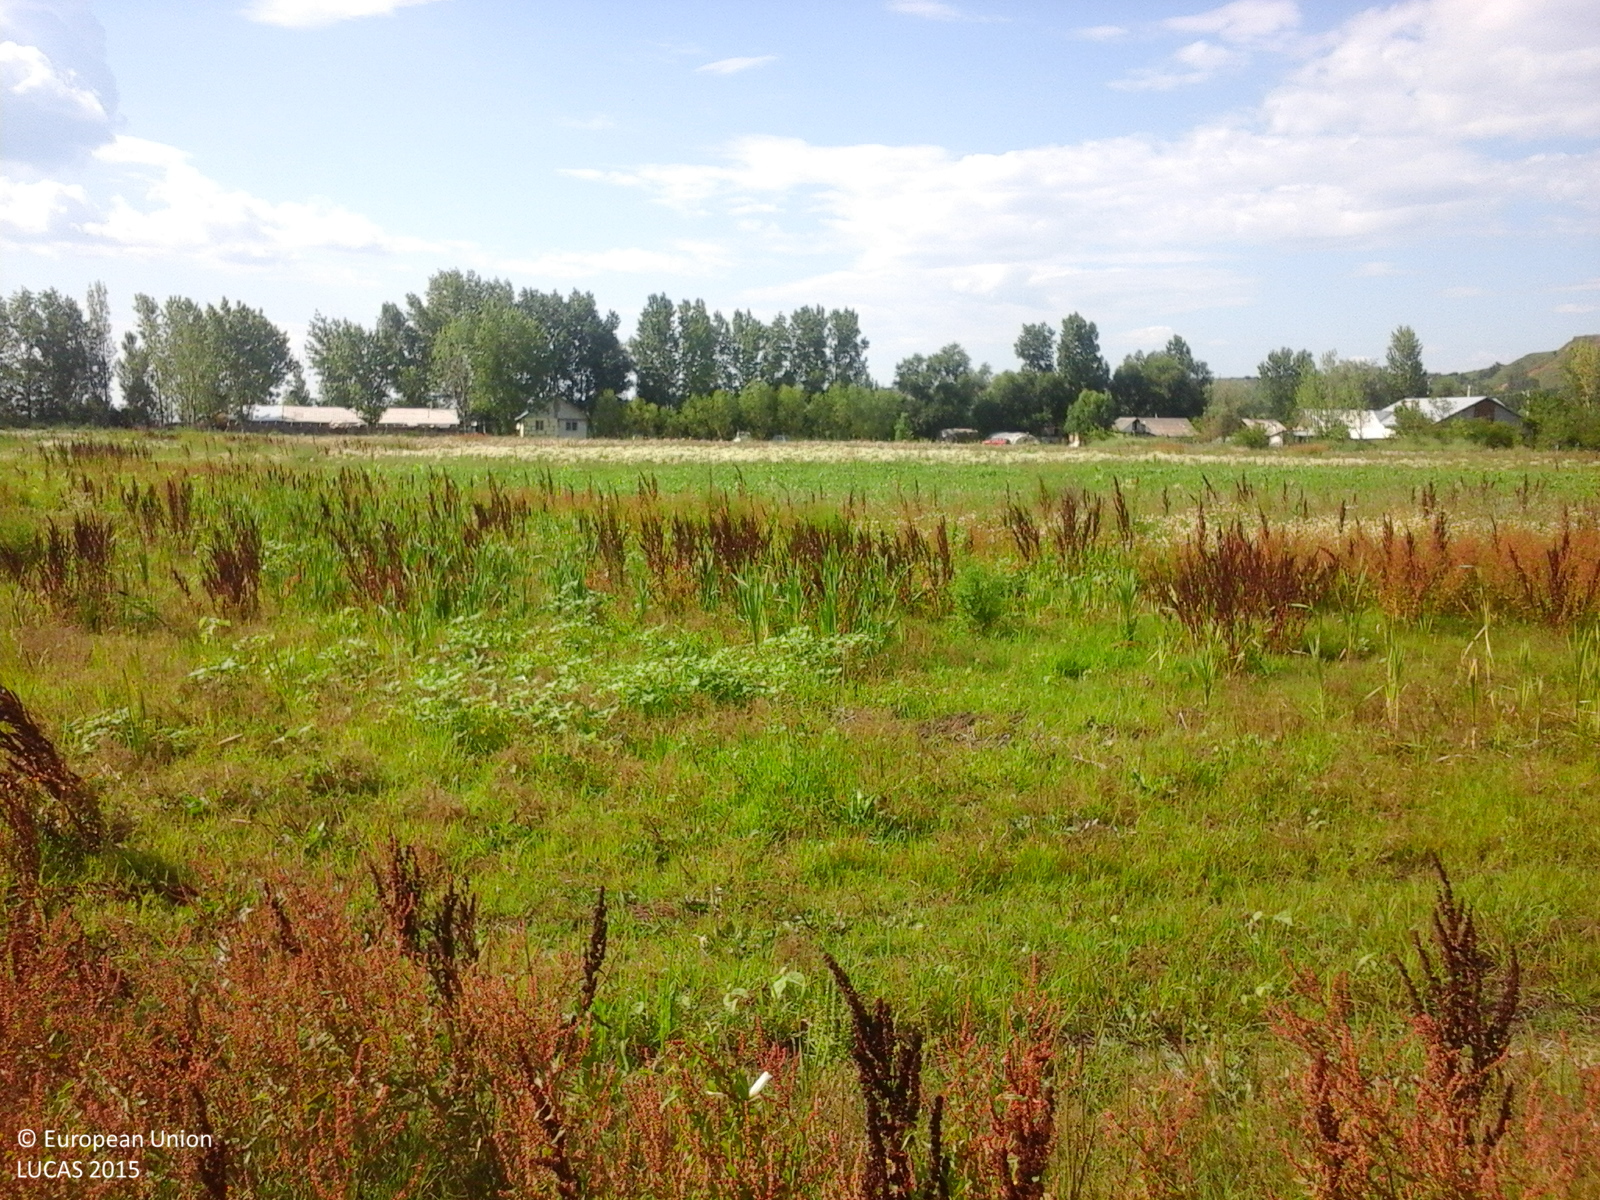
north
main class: Grassland
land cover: Grassland without tree/shrub cover
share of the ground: > 75 %
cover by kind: herbaceous plants 100 %
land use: Agriculture (excluding fallow land and kitchen gardens)
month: July
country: RO
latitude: 44.0566
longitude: 24.6370
